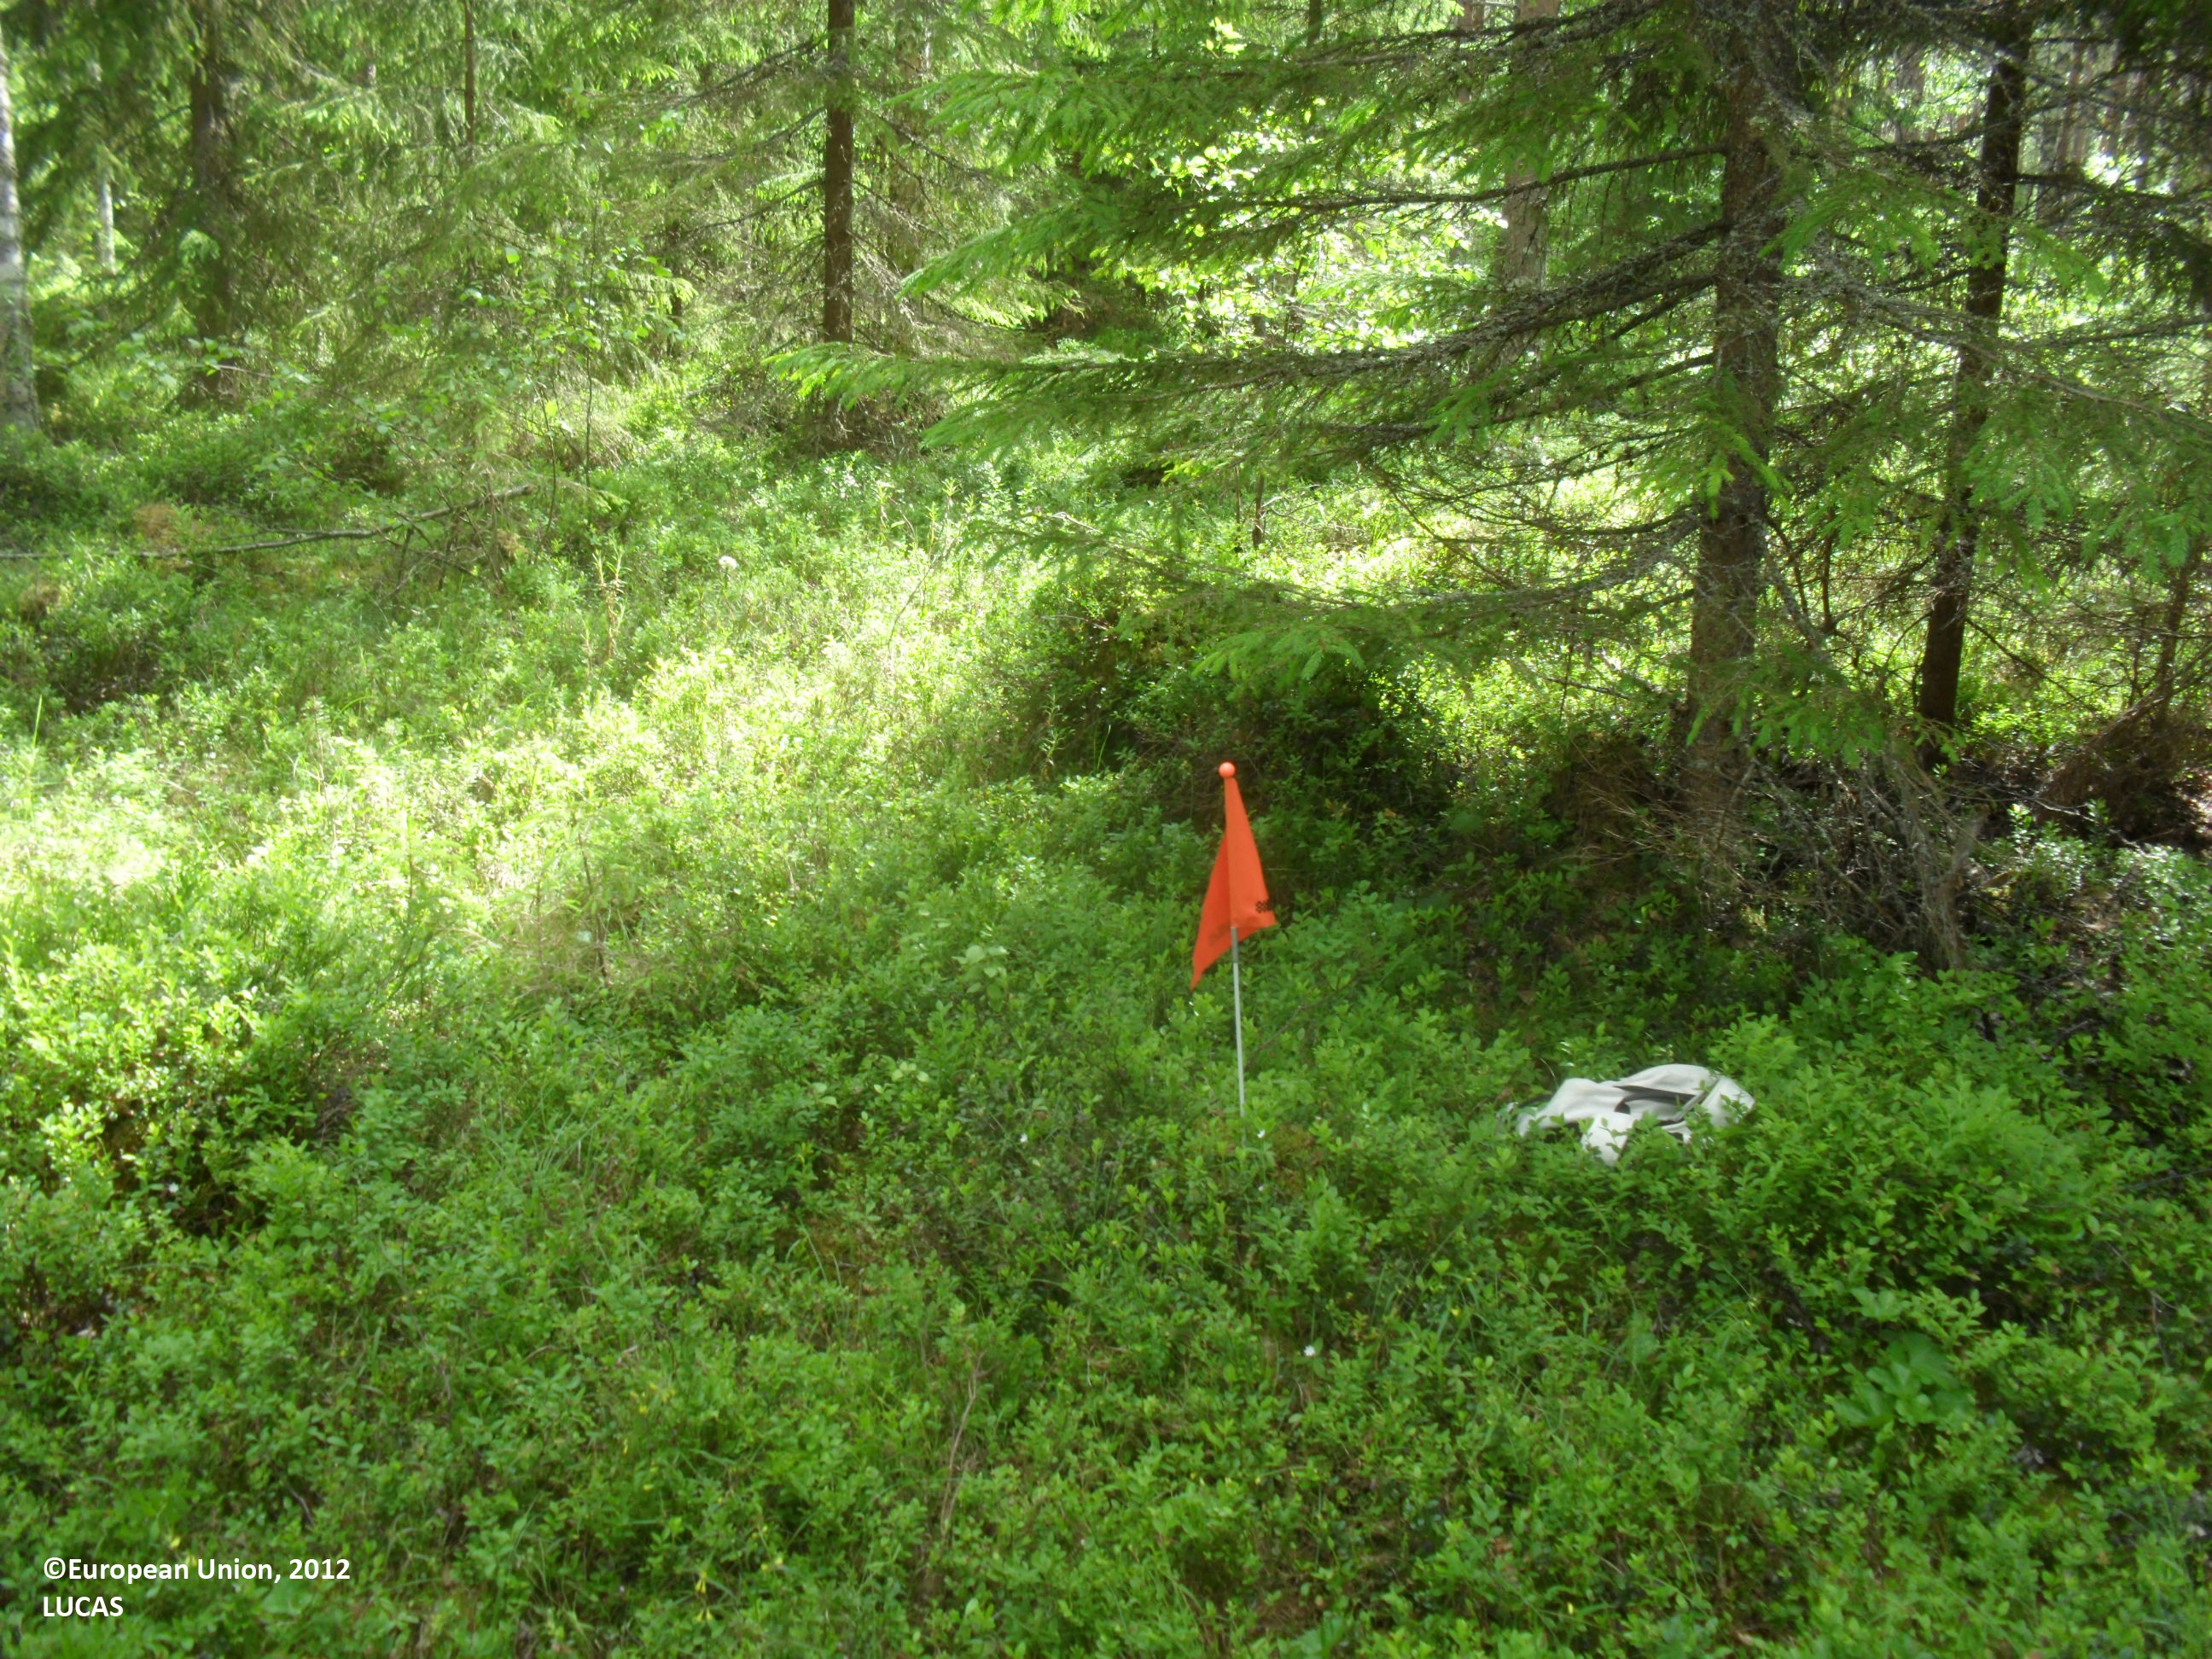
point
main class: Woodland
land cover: Other mixed woodland
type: boreal forest
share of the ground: 50 - 75 %
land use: Forestry
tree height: > 5 m
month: July
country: FI
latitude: 62.9412
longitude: 24.2477
